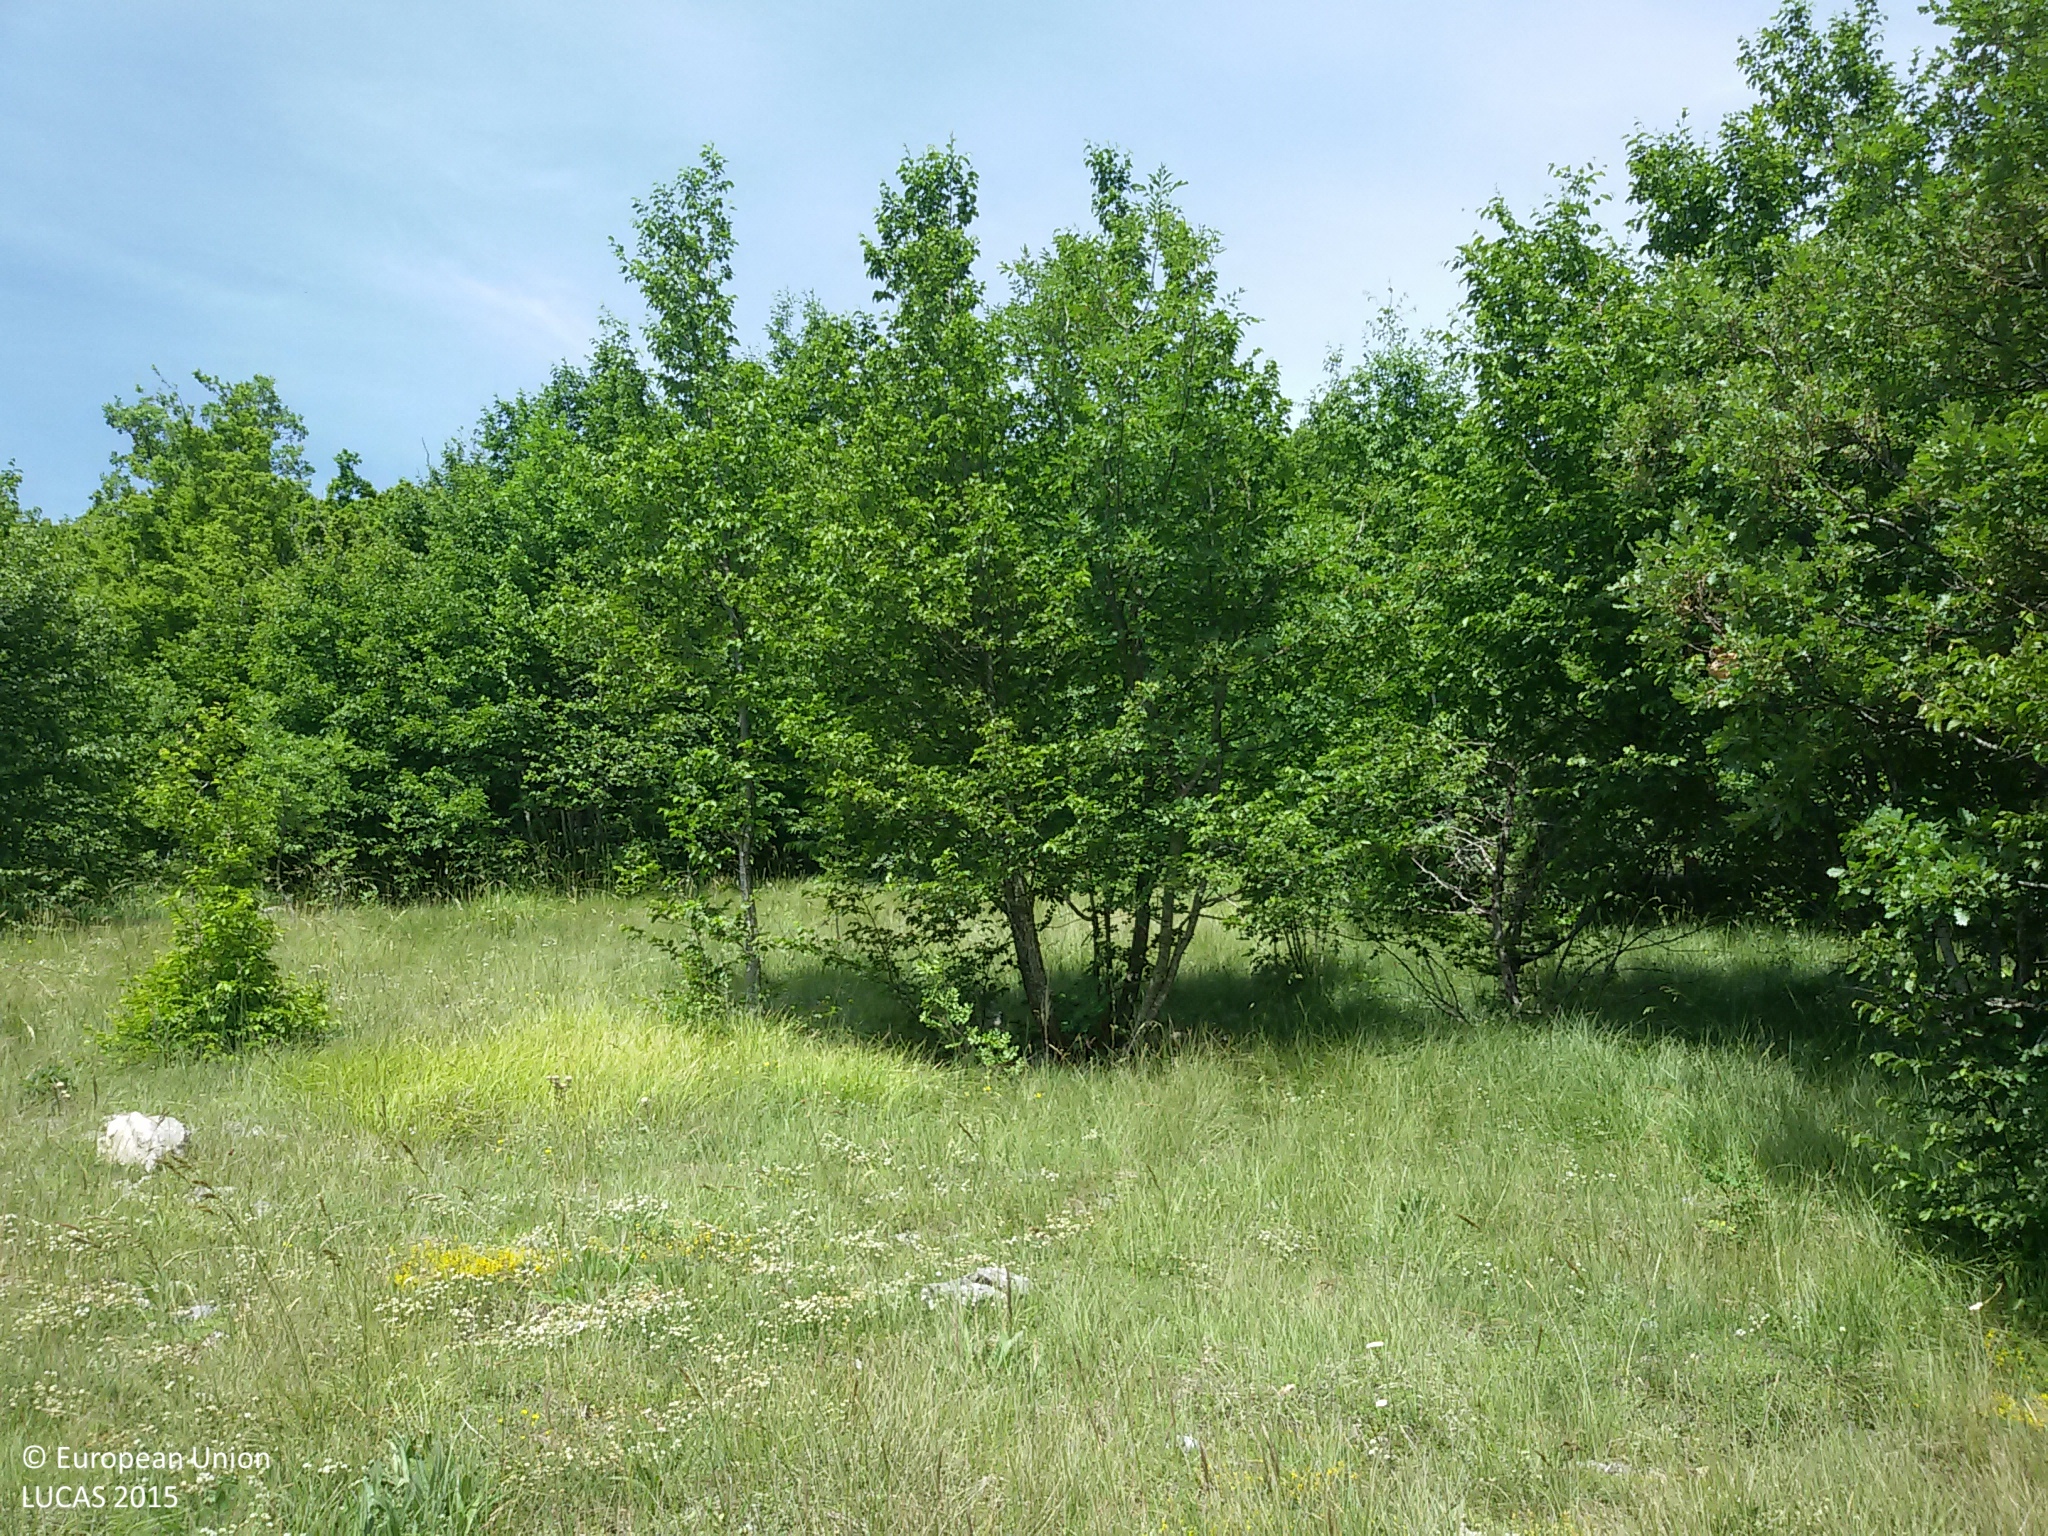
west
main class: Woodland
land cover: Broadleaved woodland
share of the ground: 10 - 25 %
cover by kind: herbaceous plants 55 %, broadleaved forest trees 15 %, unconsolidated bare surface 15 %, shrubs 10 %, consolidated bare surface 5 %
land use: Semi-natural and natural areas not in use
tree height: < 5 m
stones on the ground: < 10 %
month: June
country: HR
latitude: 44.5776
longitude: 15.6230
